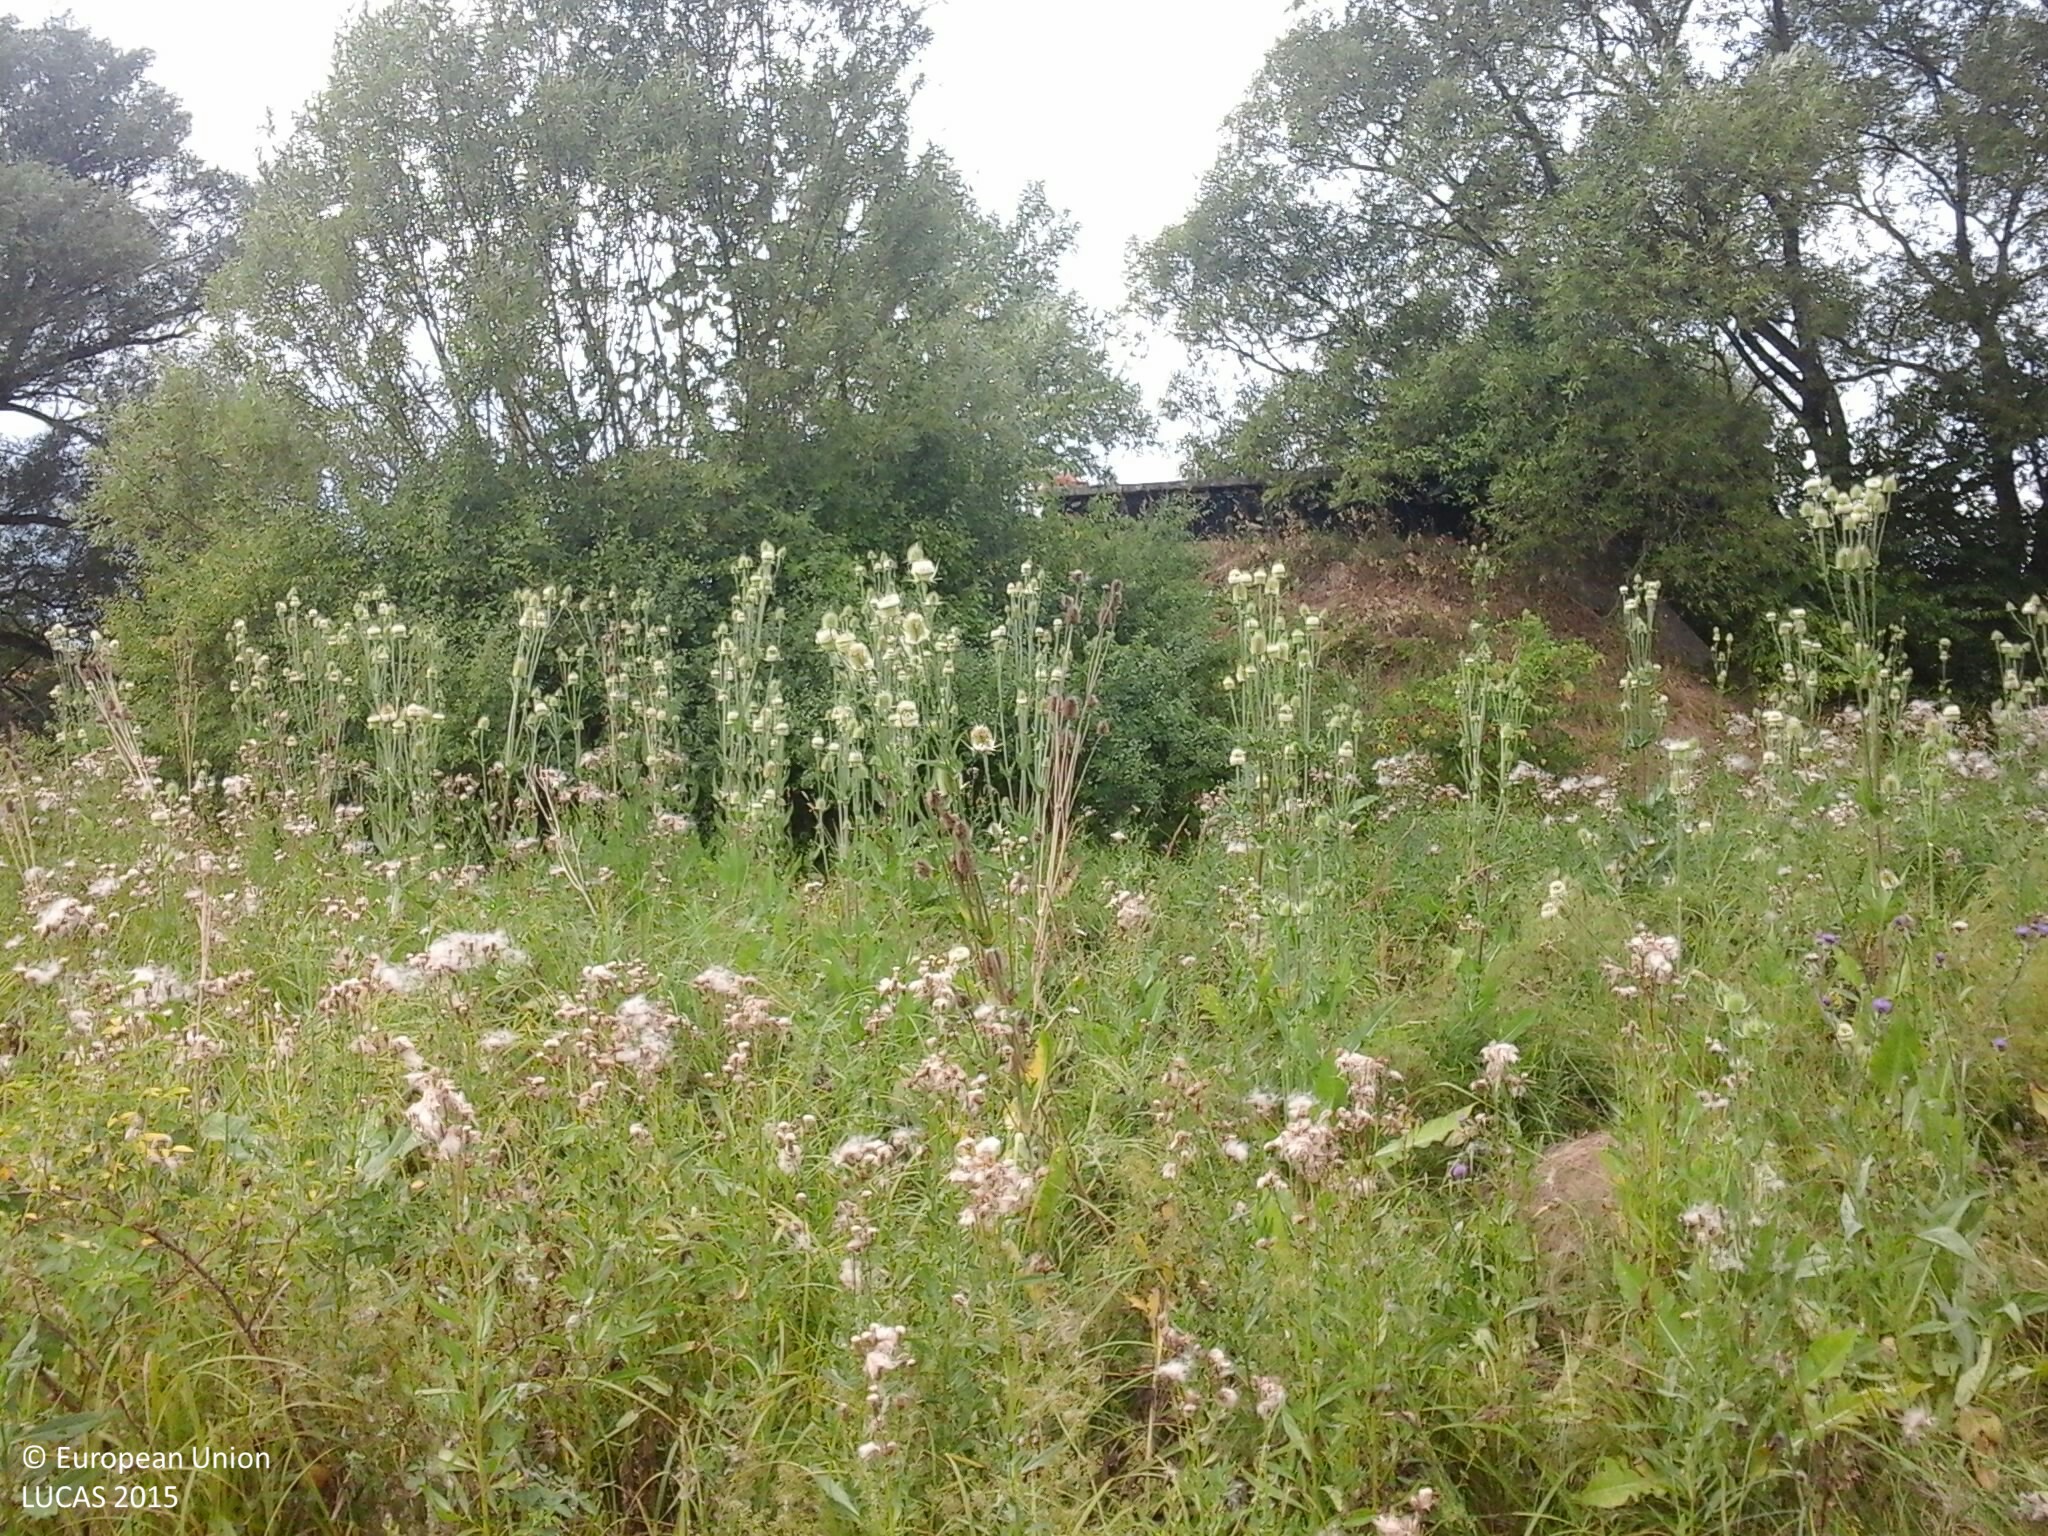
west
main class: Grassland
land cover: Grassland with sparse tree/shrub cover
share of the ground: > 75 %
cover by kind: herbaceous plants 95 %, broadleaved forest trees 5 %
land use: Semi-natural and natural areas not in use
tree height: < 5 m
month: July
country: HU
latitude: 47.9229
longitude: 19.2685
